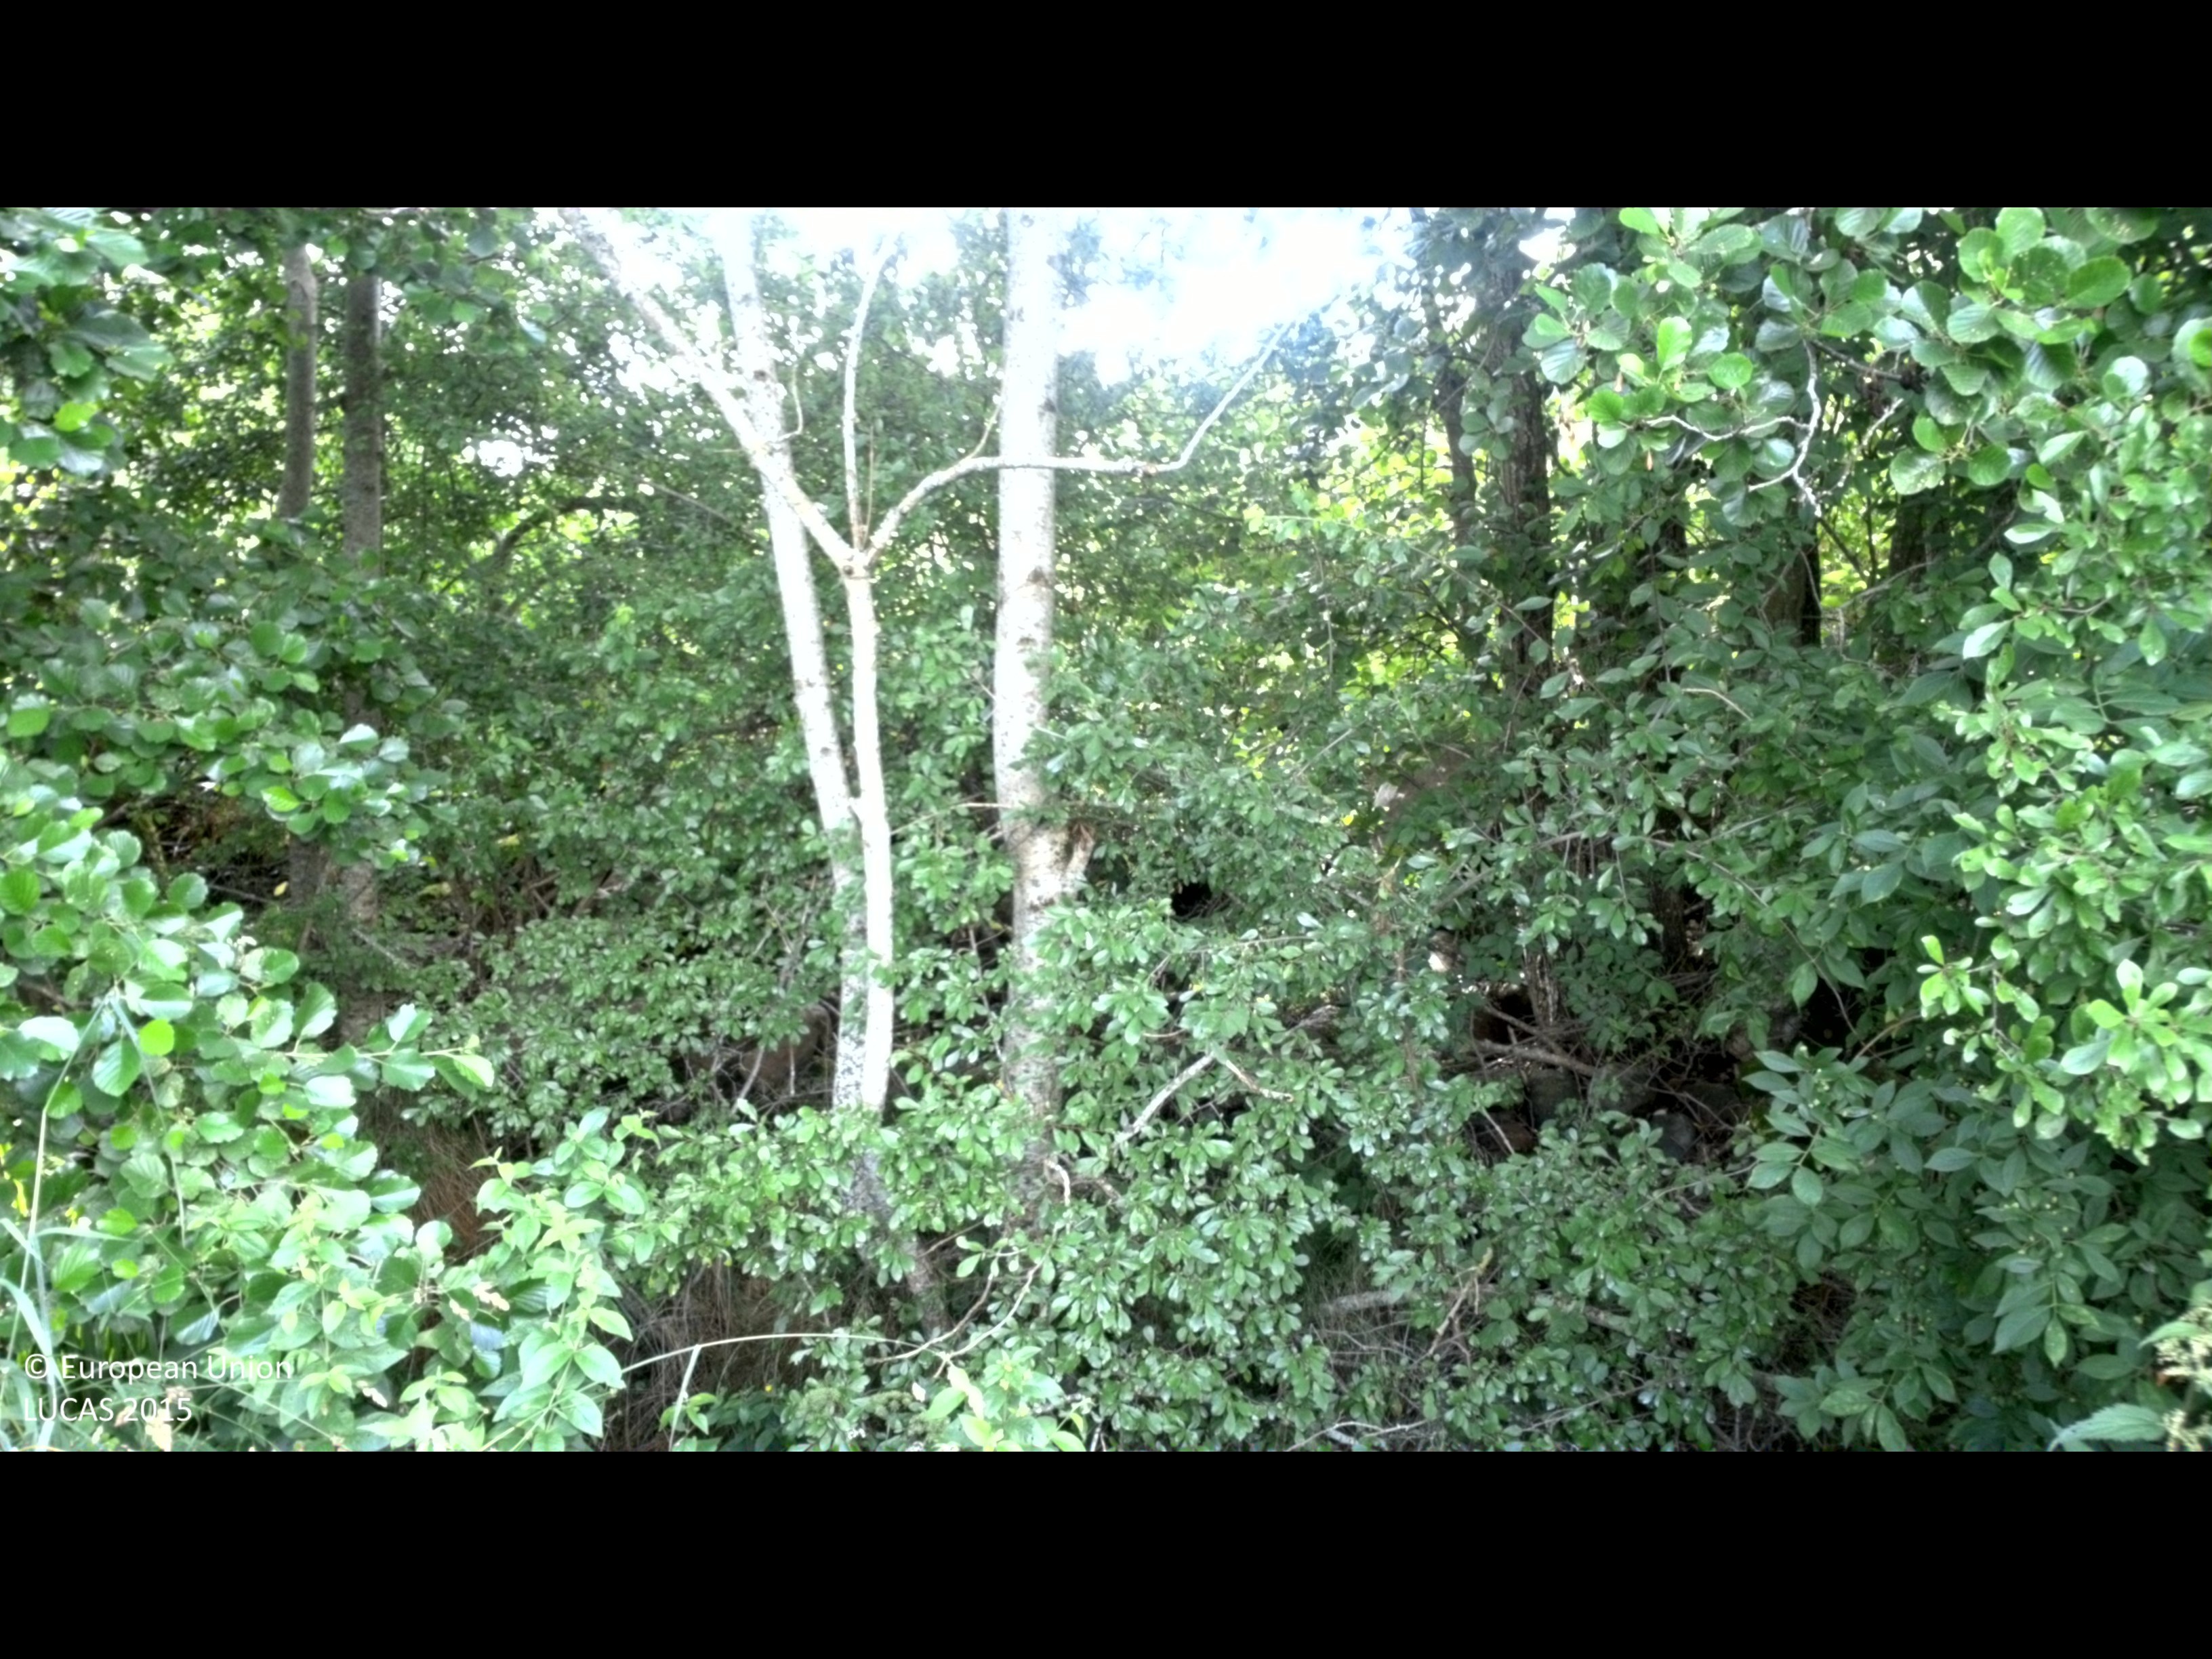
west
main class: Cropland
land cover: Dry pulses
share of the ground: > 75 %
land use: Agriculture (excluding fallow land and kitchen gardens)
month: July
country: SE
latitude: 56.6036
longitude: 16.4358
